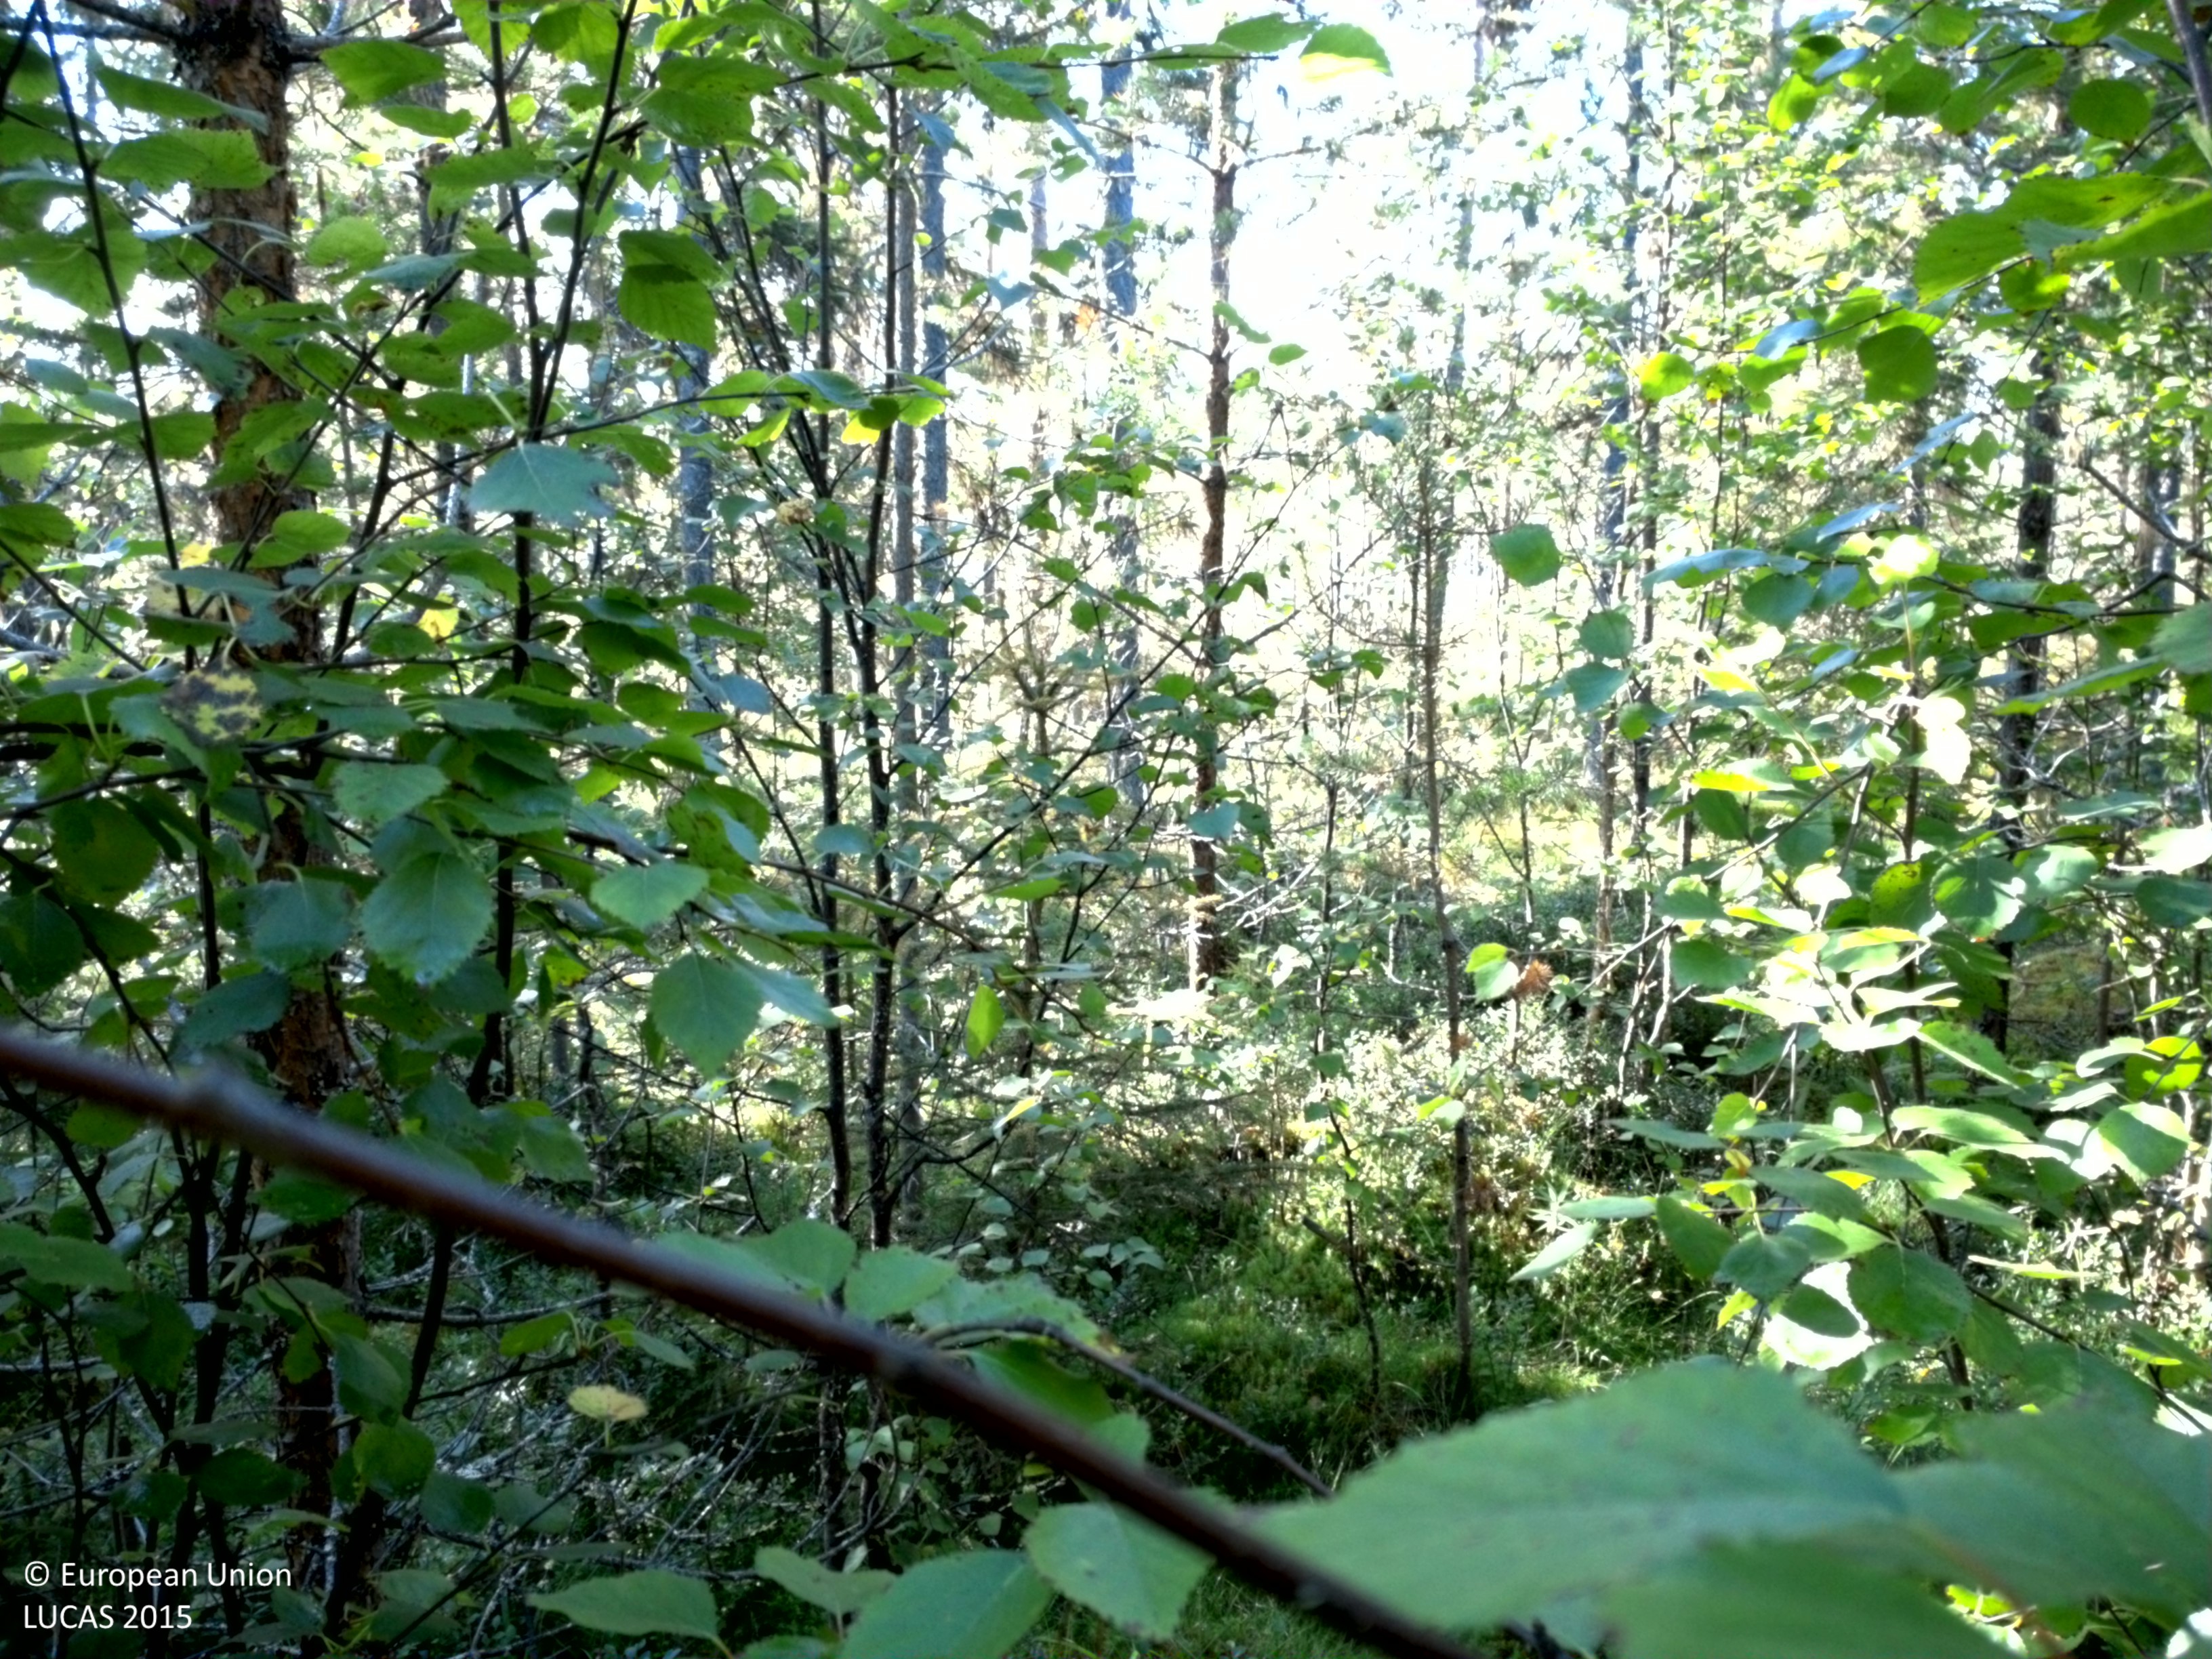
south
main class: Woodland
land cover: Pine dominated mixed woodland
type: boreal forest
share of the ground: 50 - 75 %
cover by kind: broadleaved forest trees 35 %, coniferous forest trees 30 %, shrubs 30 %, lichens and mosses 5 %
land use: Forestry
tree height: > 5 m
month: August
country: SE
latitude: 66.0636
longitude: 22.5462
